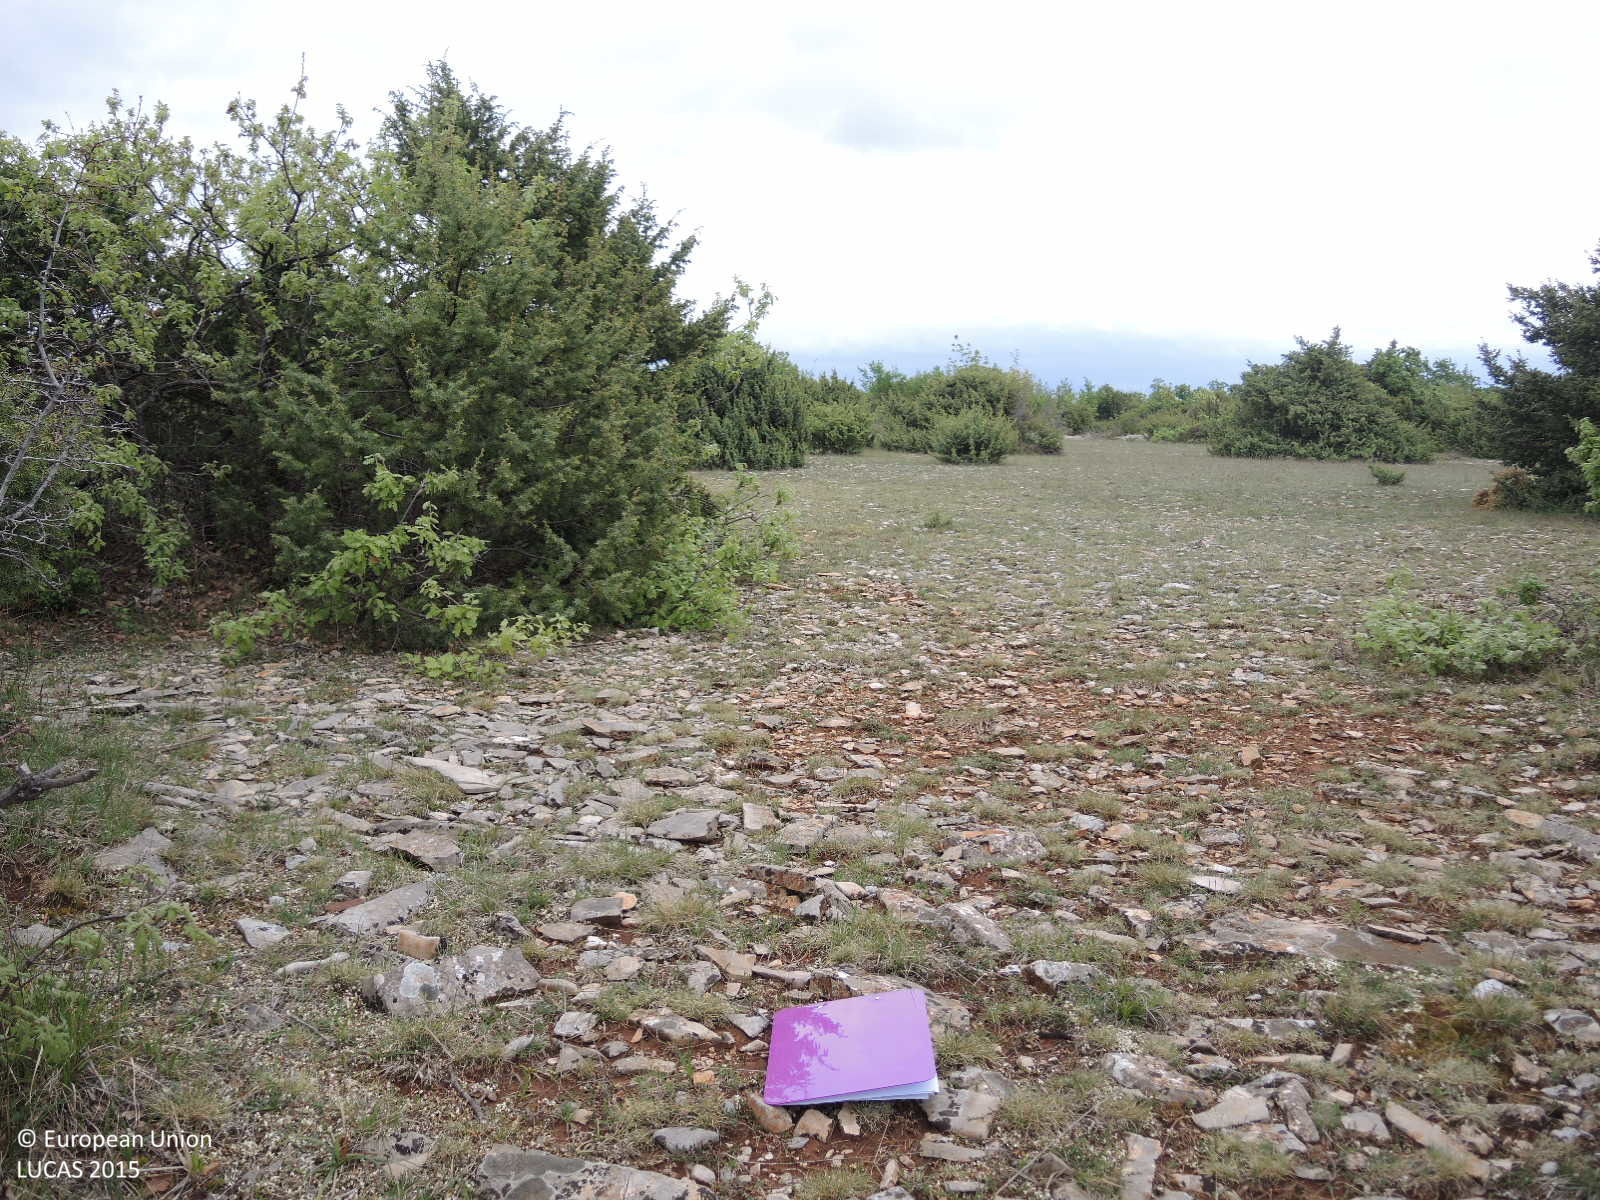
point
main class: Shrubland
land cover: Shrubland without tree cover
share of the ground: > 75 %
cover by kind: shrubs 35 %, herbaceous plants 30 %, unconsolidated bare surface 30 %, lichens and mosses 5 %
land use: Semi-natural and natural areas not in use
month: April
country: HR
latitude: 44.0922
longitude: 15.5752
